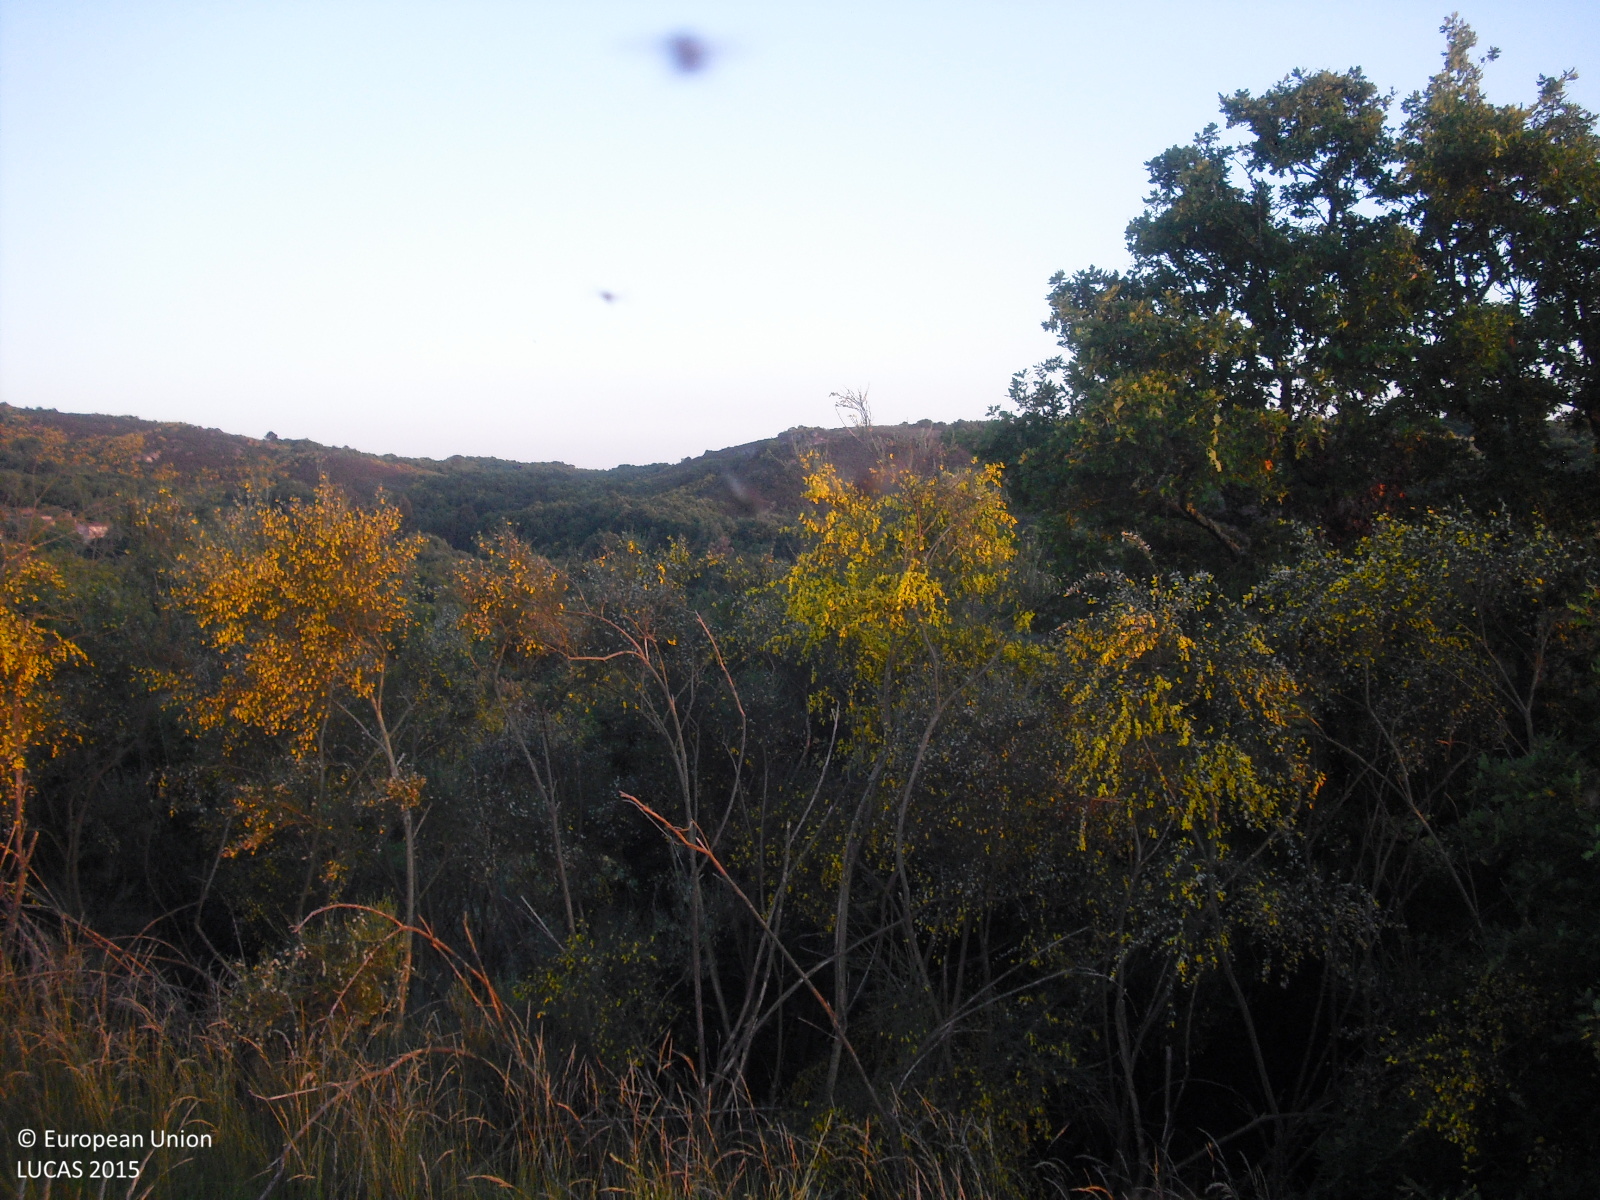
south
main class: Artificial land
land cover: Other artificial areas
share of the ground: < 10 %
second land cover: Shrubland with sparse tree cover
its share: 25 - 50 %
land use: Electricity, gas and thermal power distribution
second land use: Agriculture (excluding fallow land and kitchen gardens)
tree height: < 5 m
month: May
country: ES
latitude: 42.2025
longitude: -7.7172
